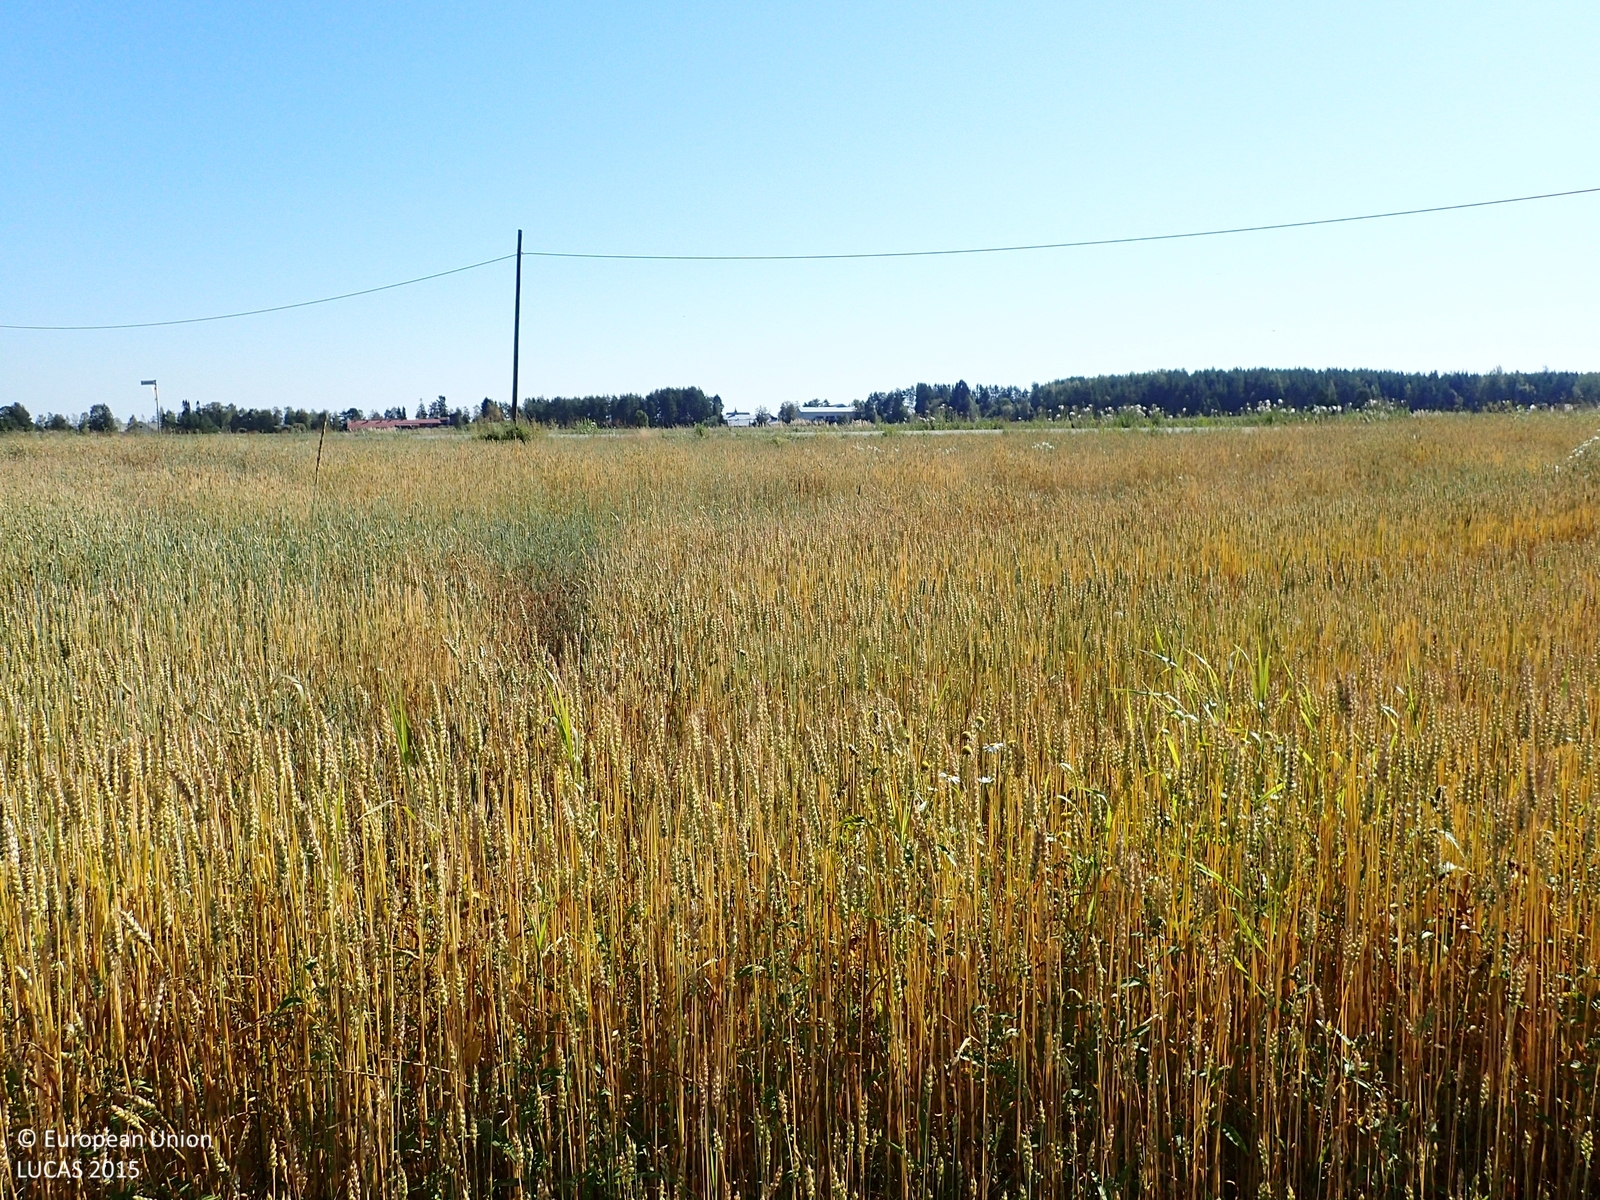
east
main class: Cropland
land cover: Common wheat
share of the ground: > 75 %
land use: Agriculture (excluding fallow land and kitchen gardens)
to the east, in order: Common wheat; Shruby margins; Ditches and canals; Shruby margins; Common wheat; Shruby margins; Ditches and canals; Grass margins; Paved roads, cycling and walking lanes; Grass margins; Ditches and canals; Shruby margins; Common wheat; Electric lines; Shruby margins; Ditches and canals; Grass margins; Paved roads, cycling and walking lanes; Grass margins; Ditches and canals; Shruby margins; Common wheat
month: August
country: FI
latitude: 62.4652
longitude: 21.6992
